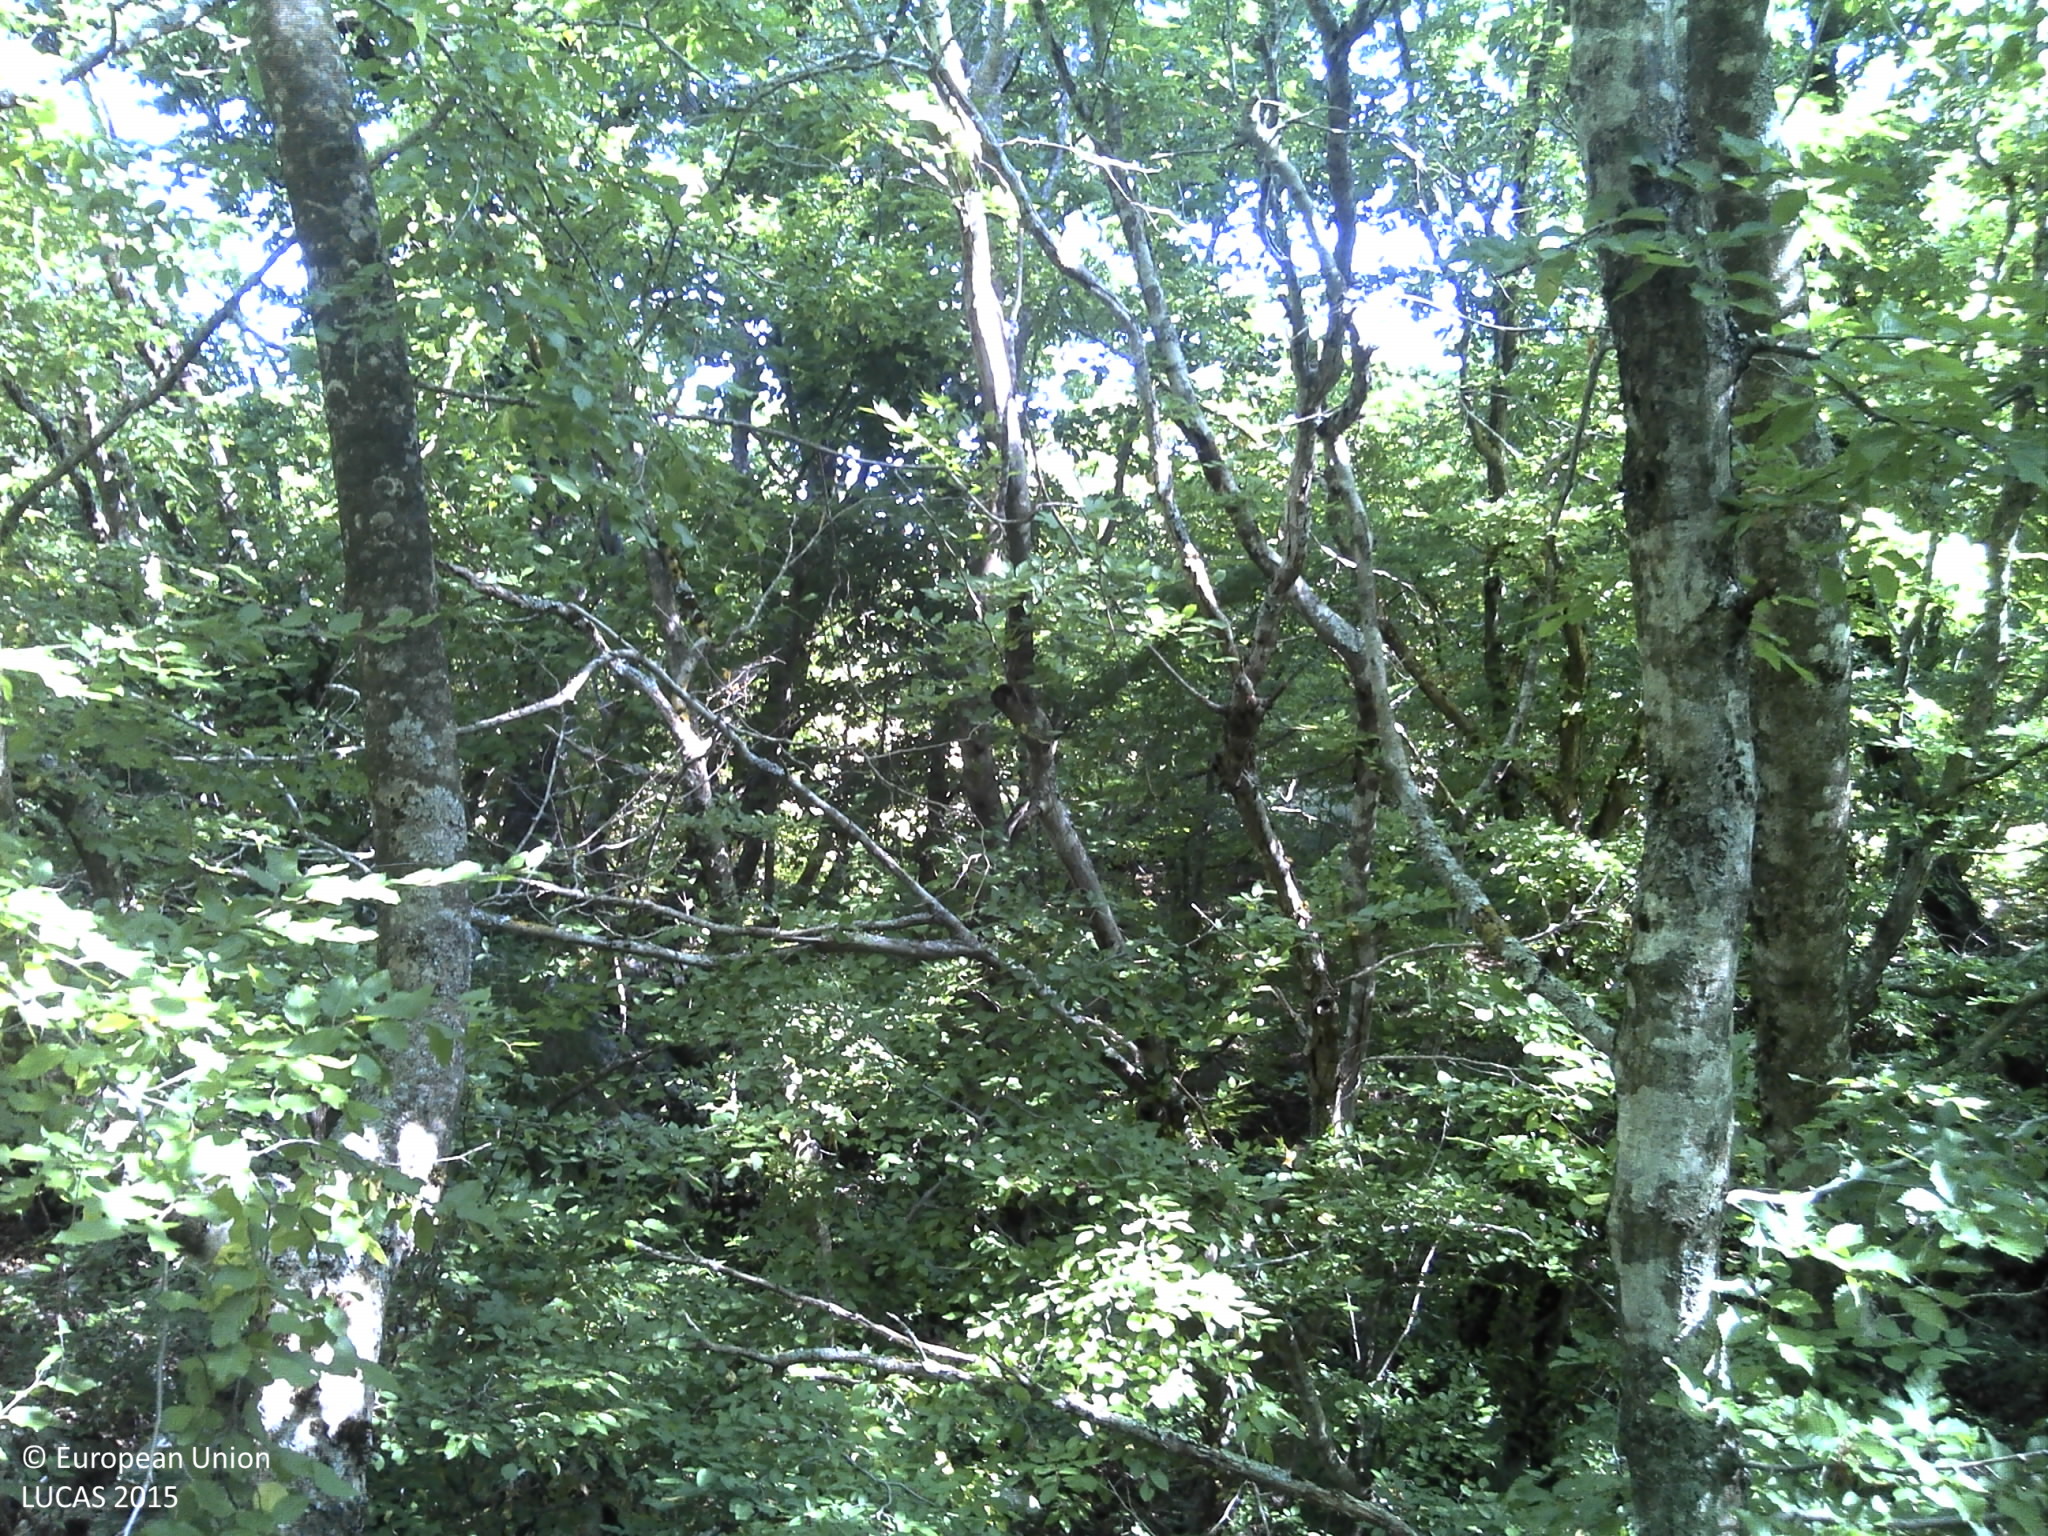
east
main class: Woodland
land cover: Broadleaved woodland
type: thermophilous deciduous forest
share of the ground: 50 - 75 %
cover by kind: broadleaved forest trees 70 %, shrubs 15 %, herbaceous plants 10 %, consolidated bare surface 5 %
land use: Semi-natural and natural areas not in use
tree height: > 5 m
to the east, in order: Broadleaved woodland; Shrubland with sparse tree cover; Grassland with sparse tree/shrub cover; Tracks; Shrubland with sparse tree cover; Tracks; Broadleaved woodland
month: July
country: HR
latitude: 43.5308
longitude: 17.0574
